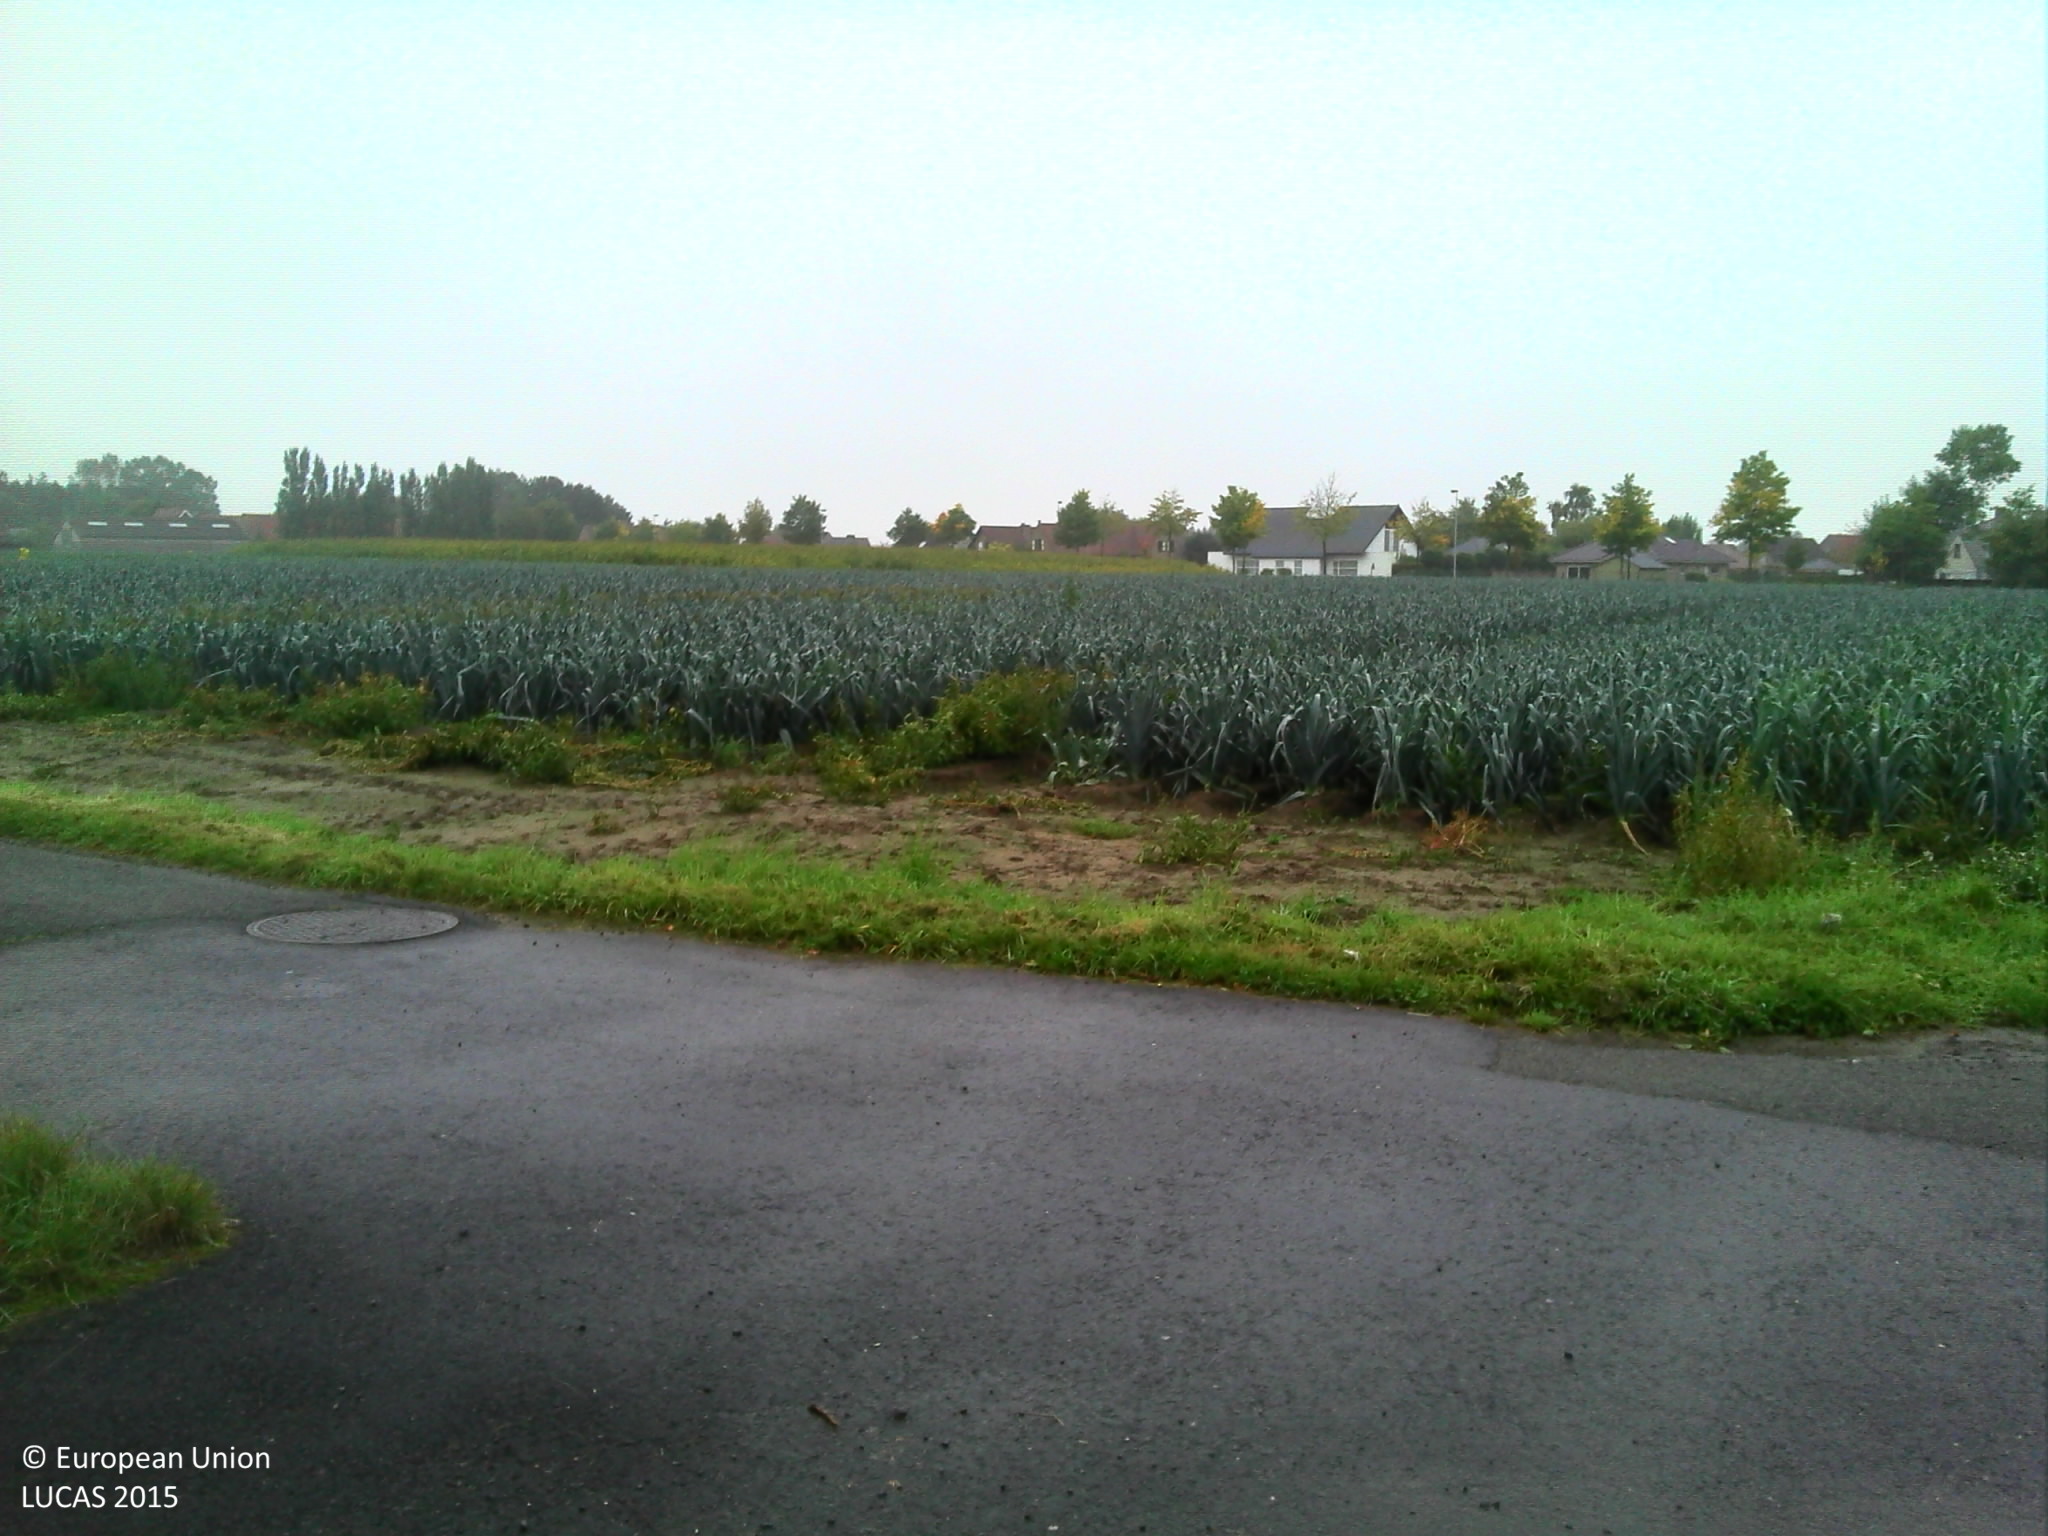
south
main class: Grassland
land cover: Grassland without tree/shrub cover
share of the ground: > 75 %
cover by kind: herbaceous plants 100 %
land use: Sport
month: October
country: BE
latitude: 51.0262
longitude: 2.8746
